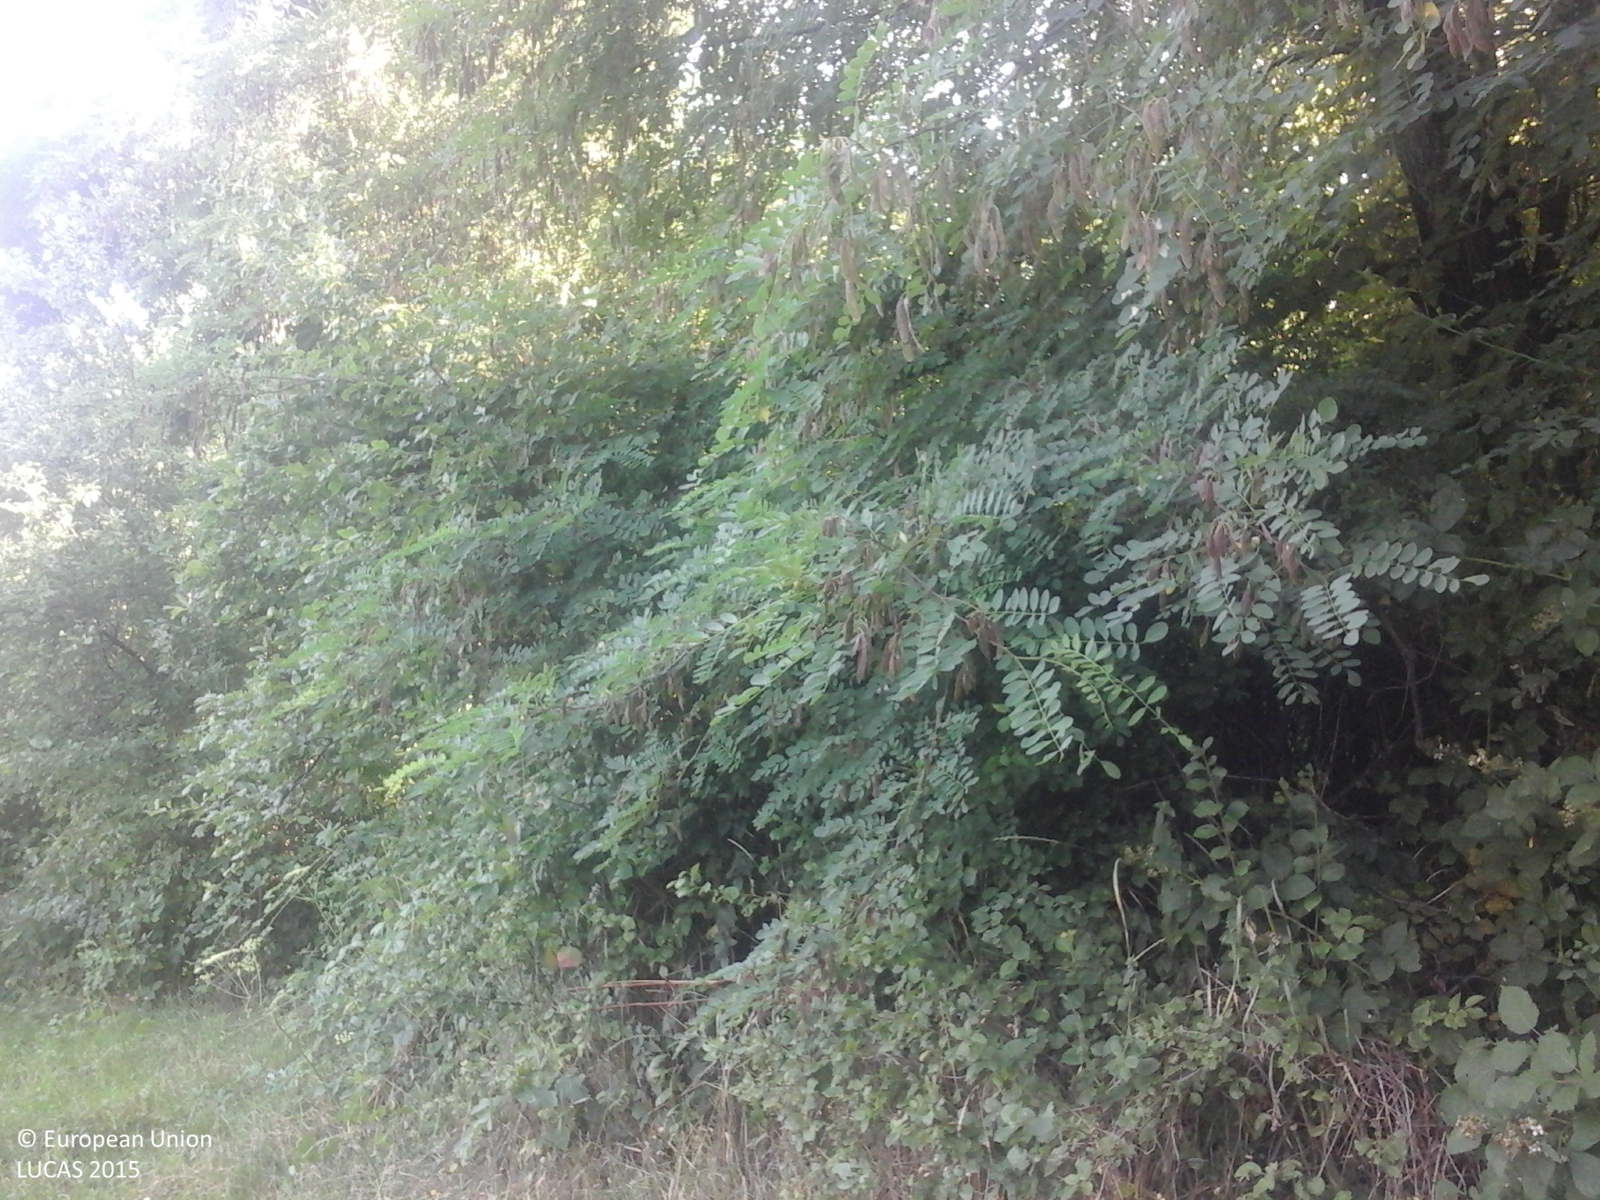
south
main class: Woodland
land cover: Broadleaved woodland
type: exotic forest
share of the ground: > 75 %
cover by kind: broadleaved forest trees 100 %
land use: Forestry
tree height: > 5 m
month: July
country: RO
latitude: 45.0371
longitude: 24.4313
